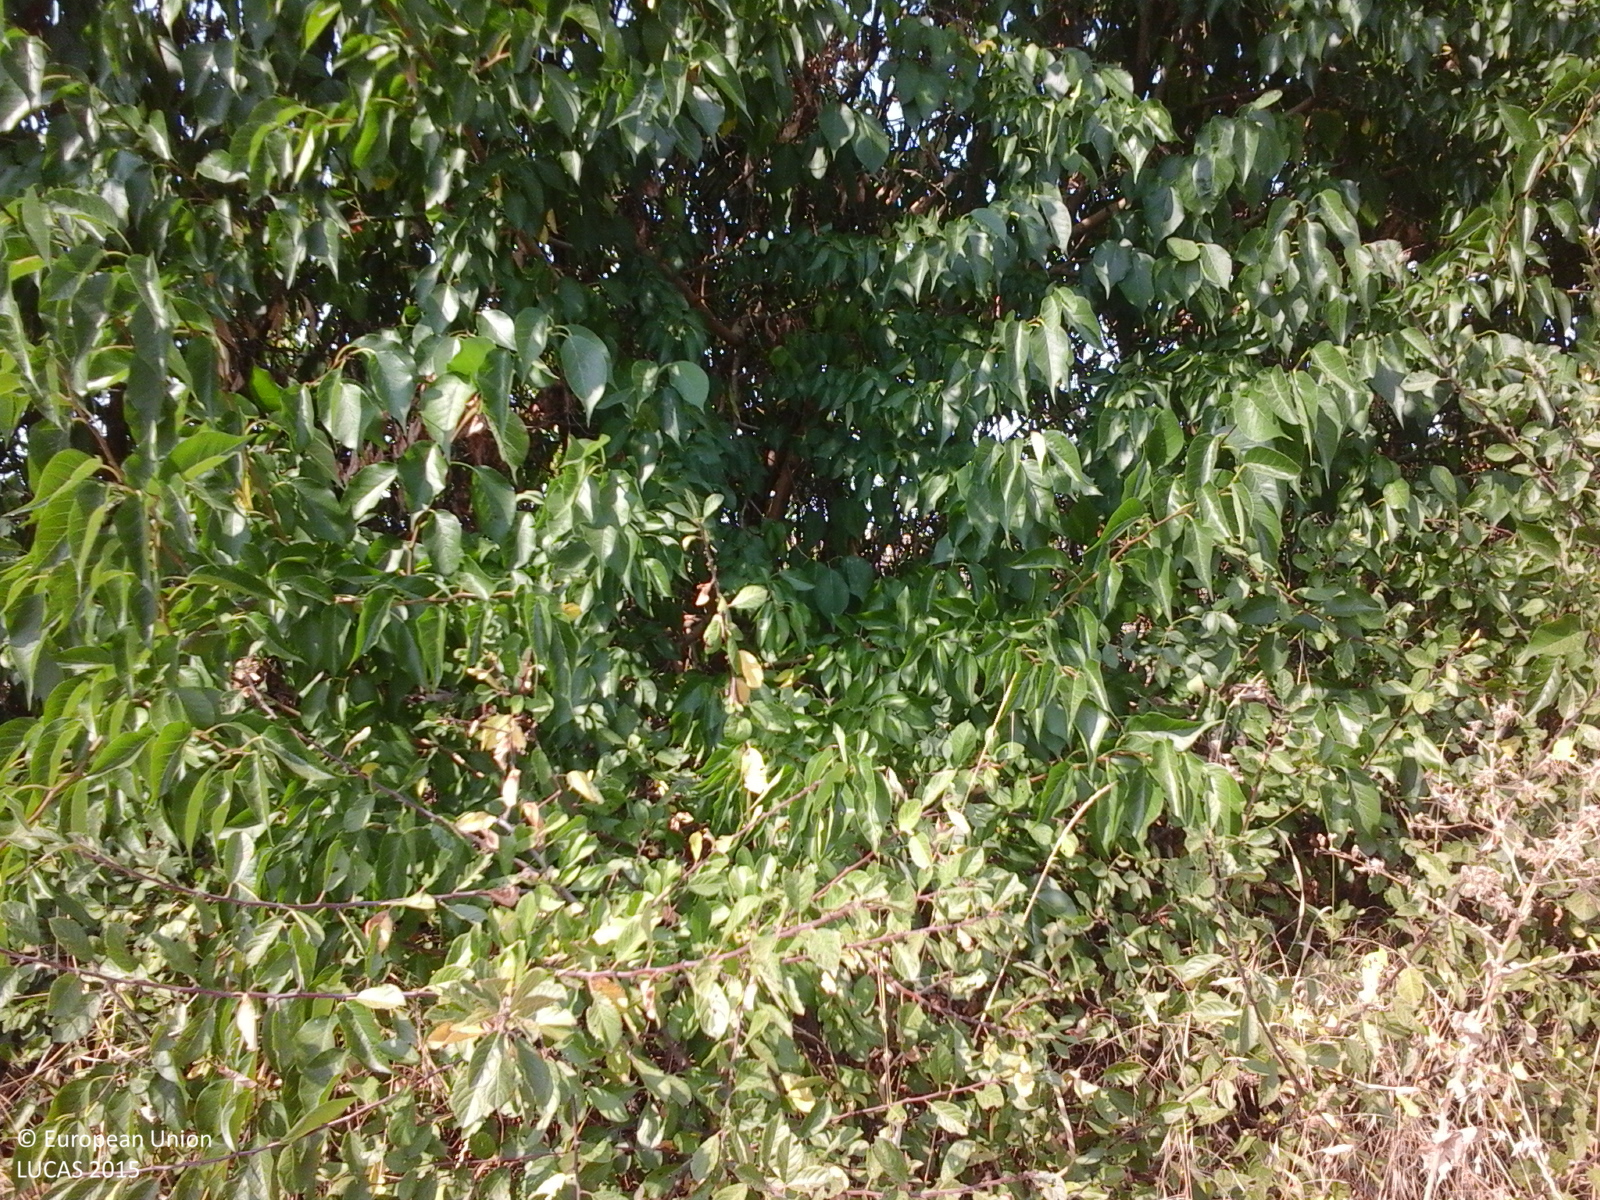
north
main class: Shrubland
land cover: Shrubland with sparse tree cover
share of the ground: > 75 %
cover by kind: shrubs 95 %, broadleaved forest trees 5 %
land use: Semi-natural and natural areas not in use
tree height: > 5 m
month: August
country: RO
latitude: 44.3680
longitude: 23.5683
